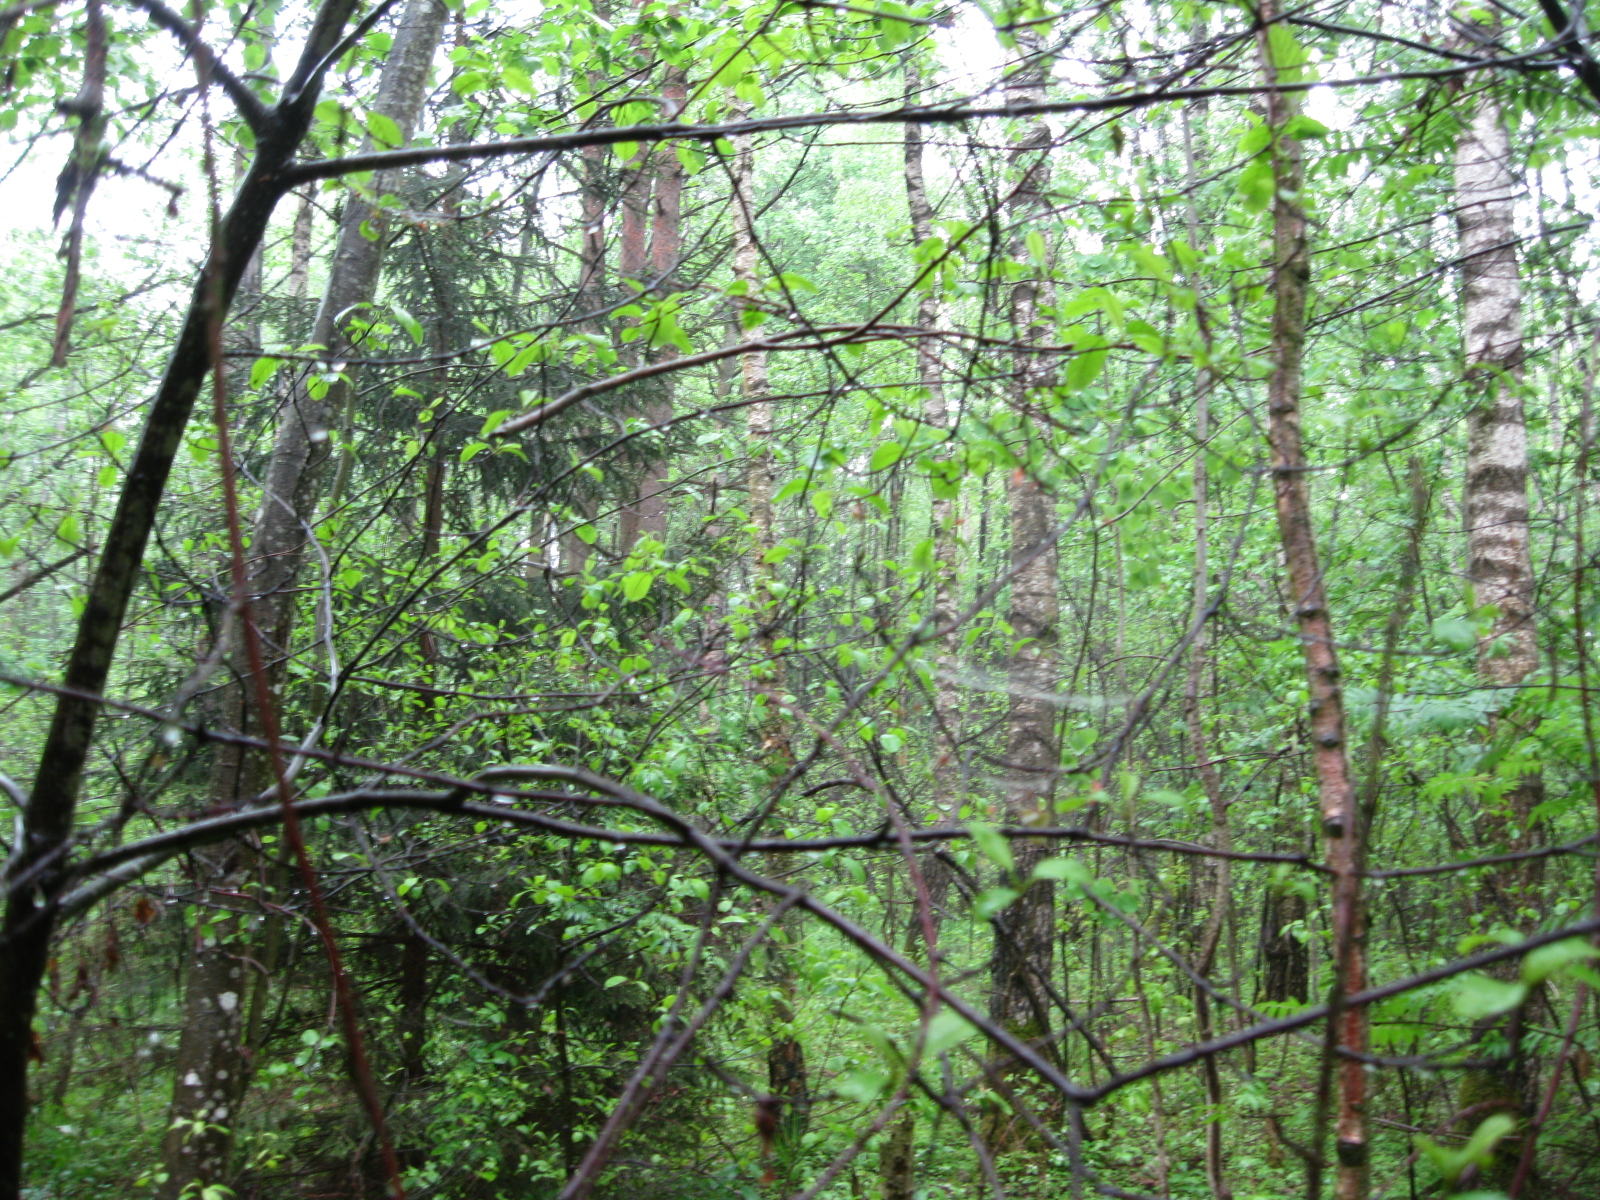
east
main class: Woodland
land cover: Broadleaved woodland
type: non-riverine alder, birch or aspen forest
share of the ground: > 75 %
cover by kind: broadleaved forest trees 80 %, coniferous forest trees 10 %, shrubs 5 %, herbaceous plants 5 %
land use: Forestry
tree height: > 5 m
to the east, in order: Broadleaved woodland; Other mixed woodland; Pine dominated mixed woodland; Other mixed woodland
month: May
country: LT
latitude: 55.8850
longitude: 24.3724
